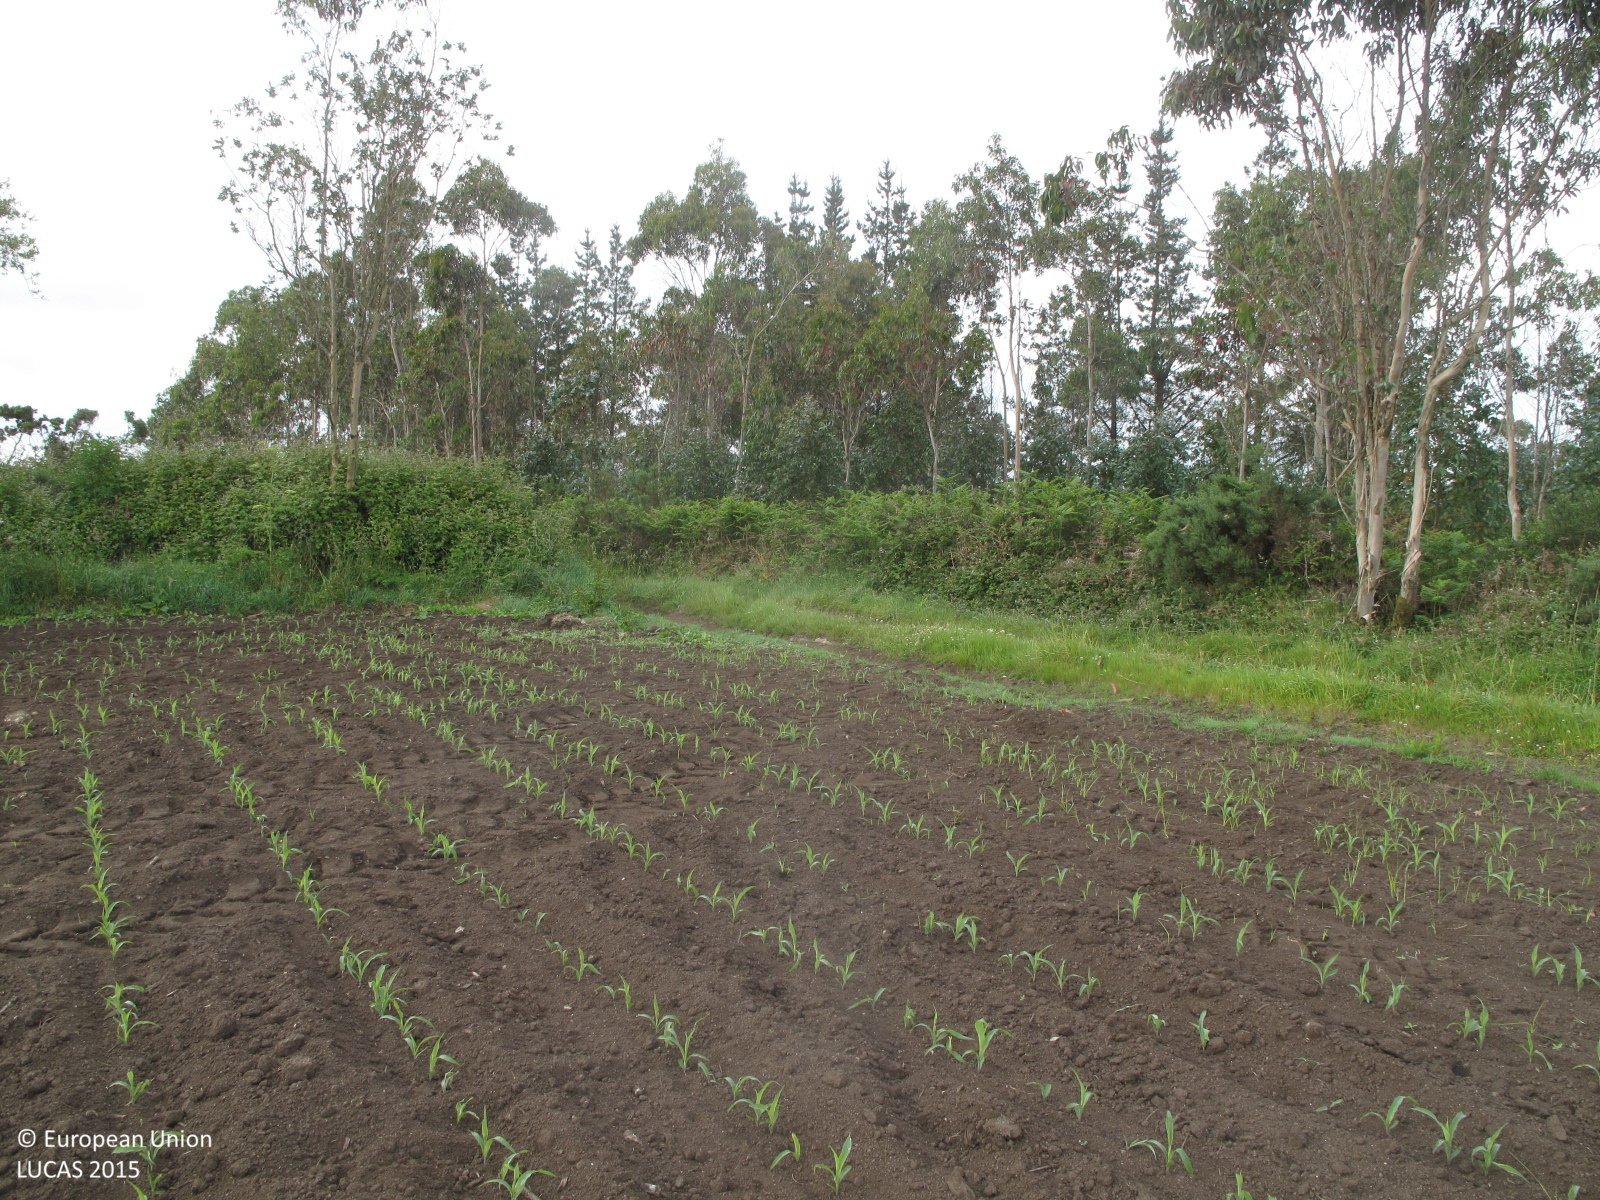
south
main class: Cropland
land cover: Maize
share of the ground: < 10 %
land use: Agriculture (excluding fallow land and kitchen gardens)
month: June
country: ES
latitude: 43.1771
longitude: -8.5498
